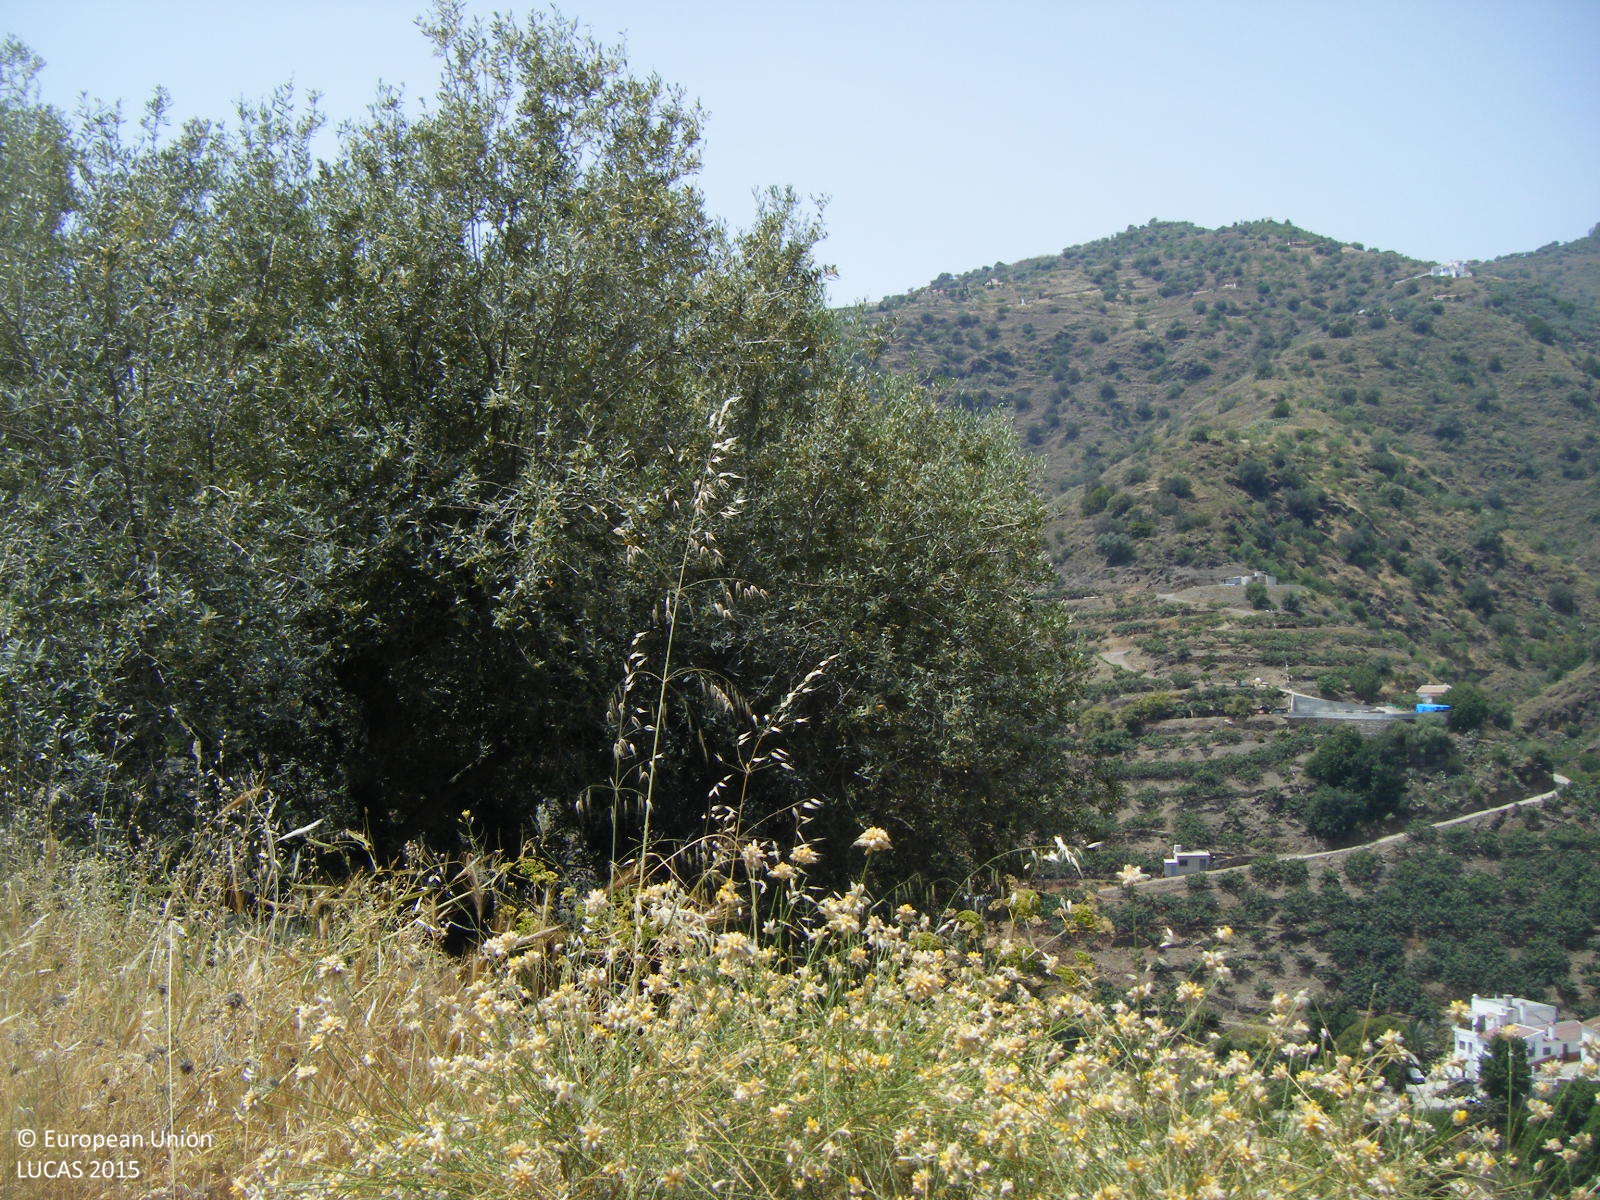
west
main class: Cropland
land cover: Other fruit trees and berries
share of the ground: 25 - 50 %
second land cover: Spontaneously vegetated surfaces
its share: > 75 %
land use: Agriculture (excluding fallow land and kitchen gardens)
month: May
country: ES
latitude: 36.7938
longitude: -4.0292
